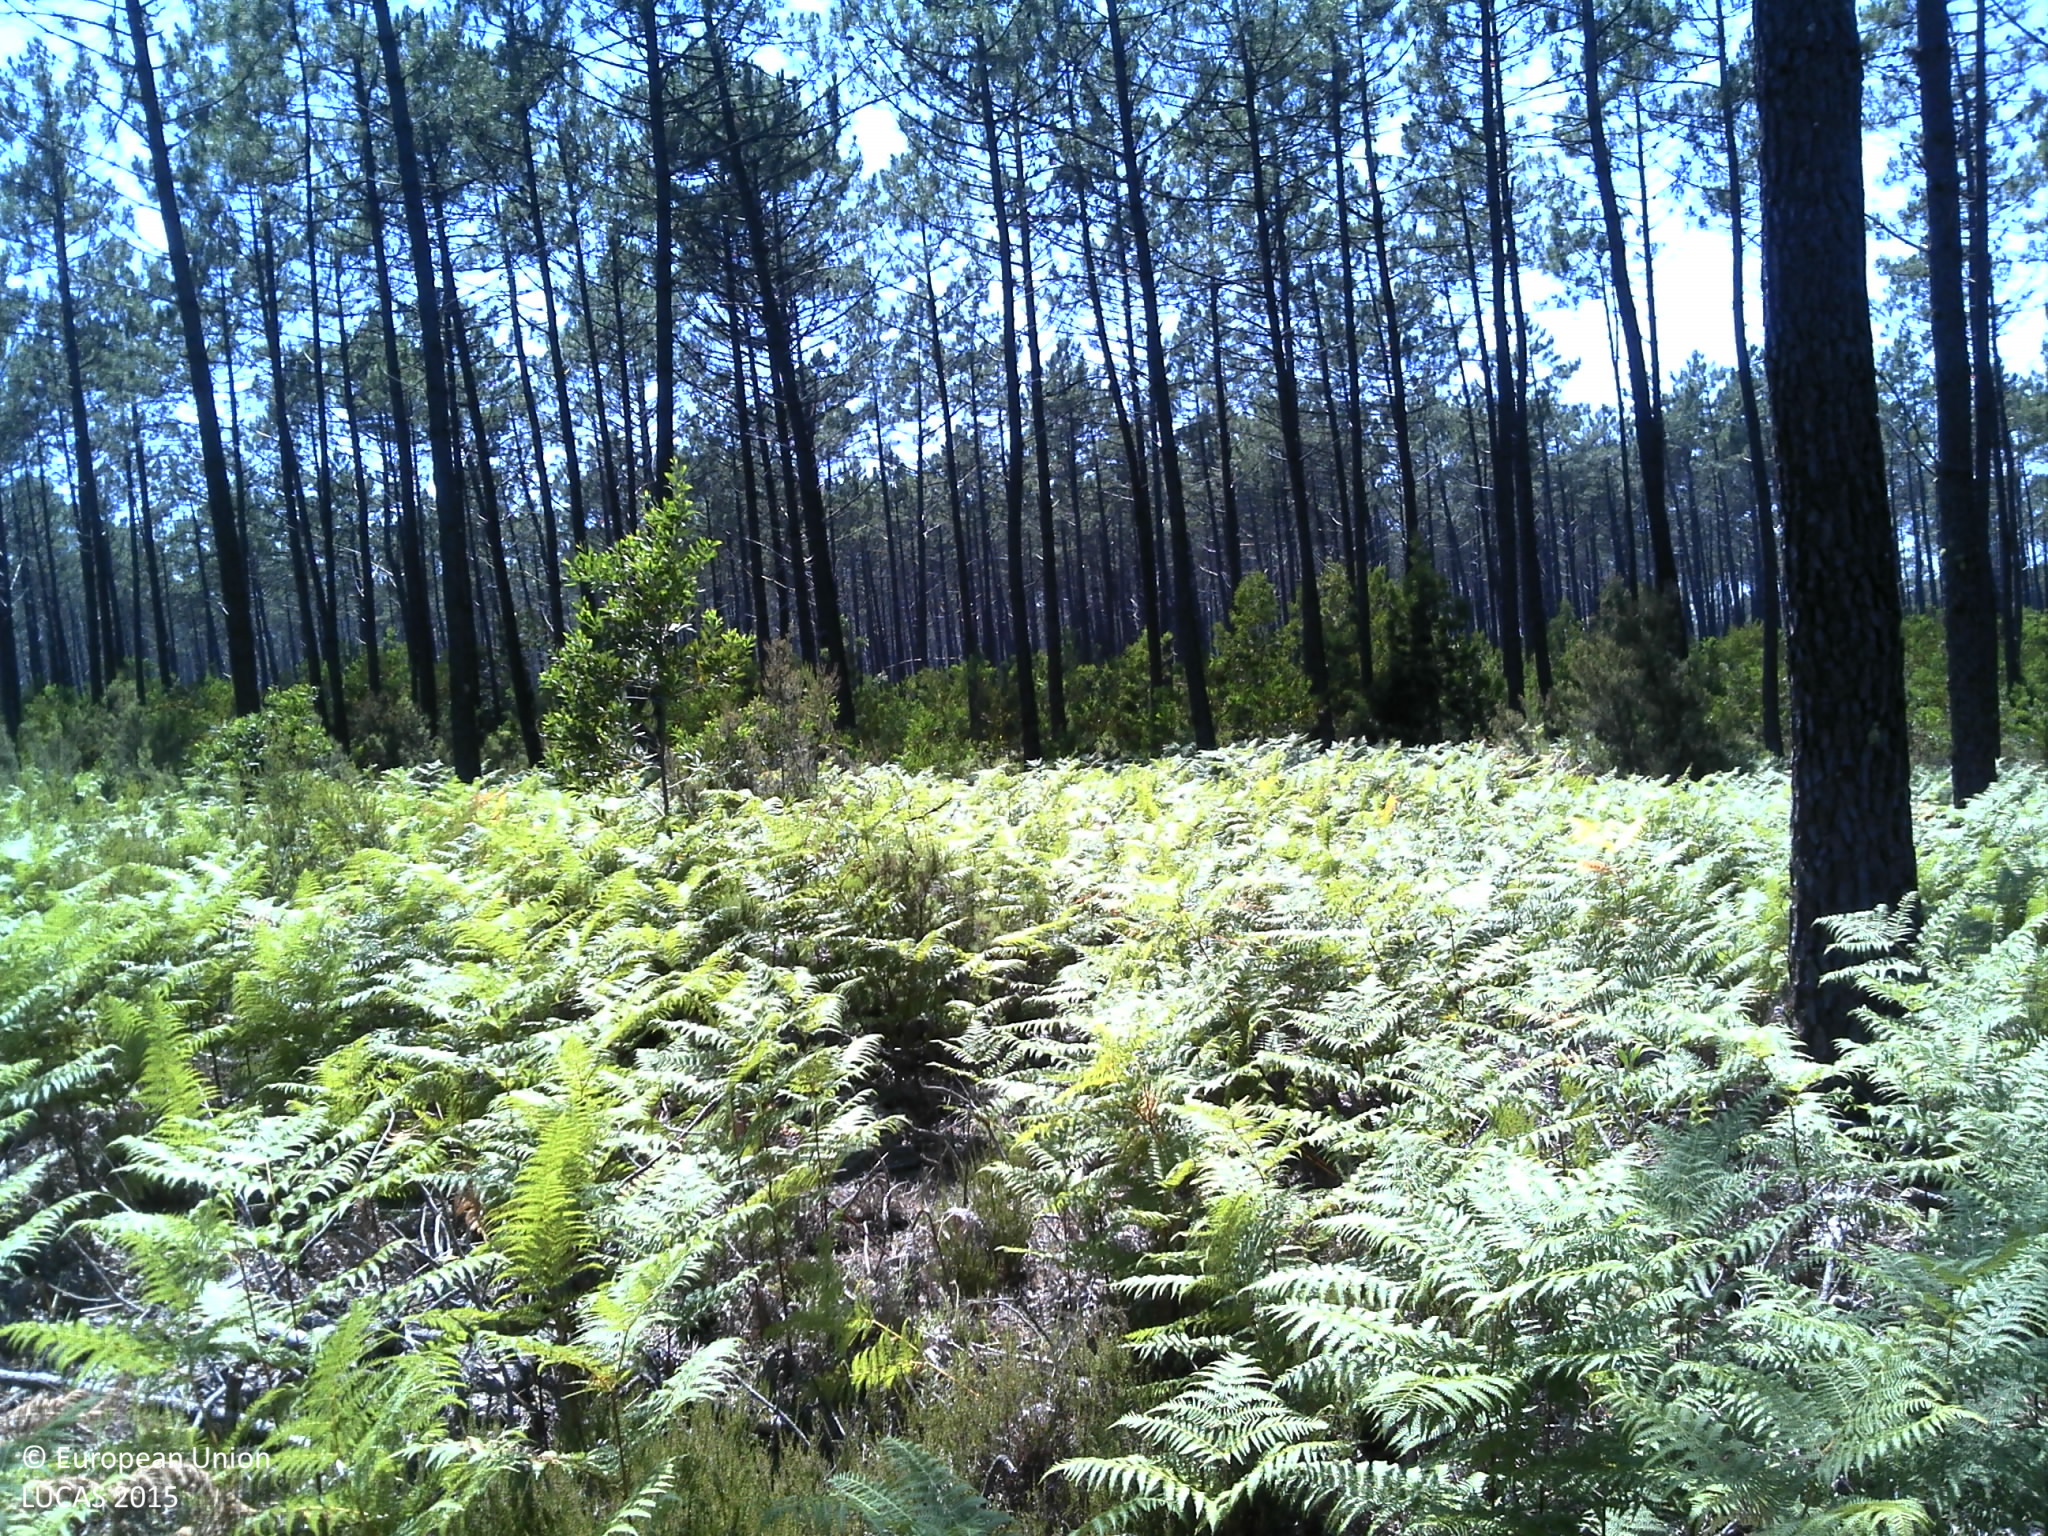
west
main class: Woodland
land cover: Pine dominated coniferous woodland
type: coniferous forest of the mediterranean region
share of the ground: 50 - 75 %
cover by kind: coniferous forest trees 50 %, unconsolidated bare surface 25 %, herbaceous plants 15 %, shrubs 10 %
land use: Forestry
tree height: > 5 m
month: June
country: PT
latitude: 39.8343
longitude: -8.9154
